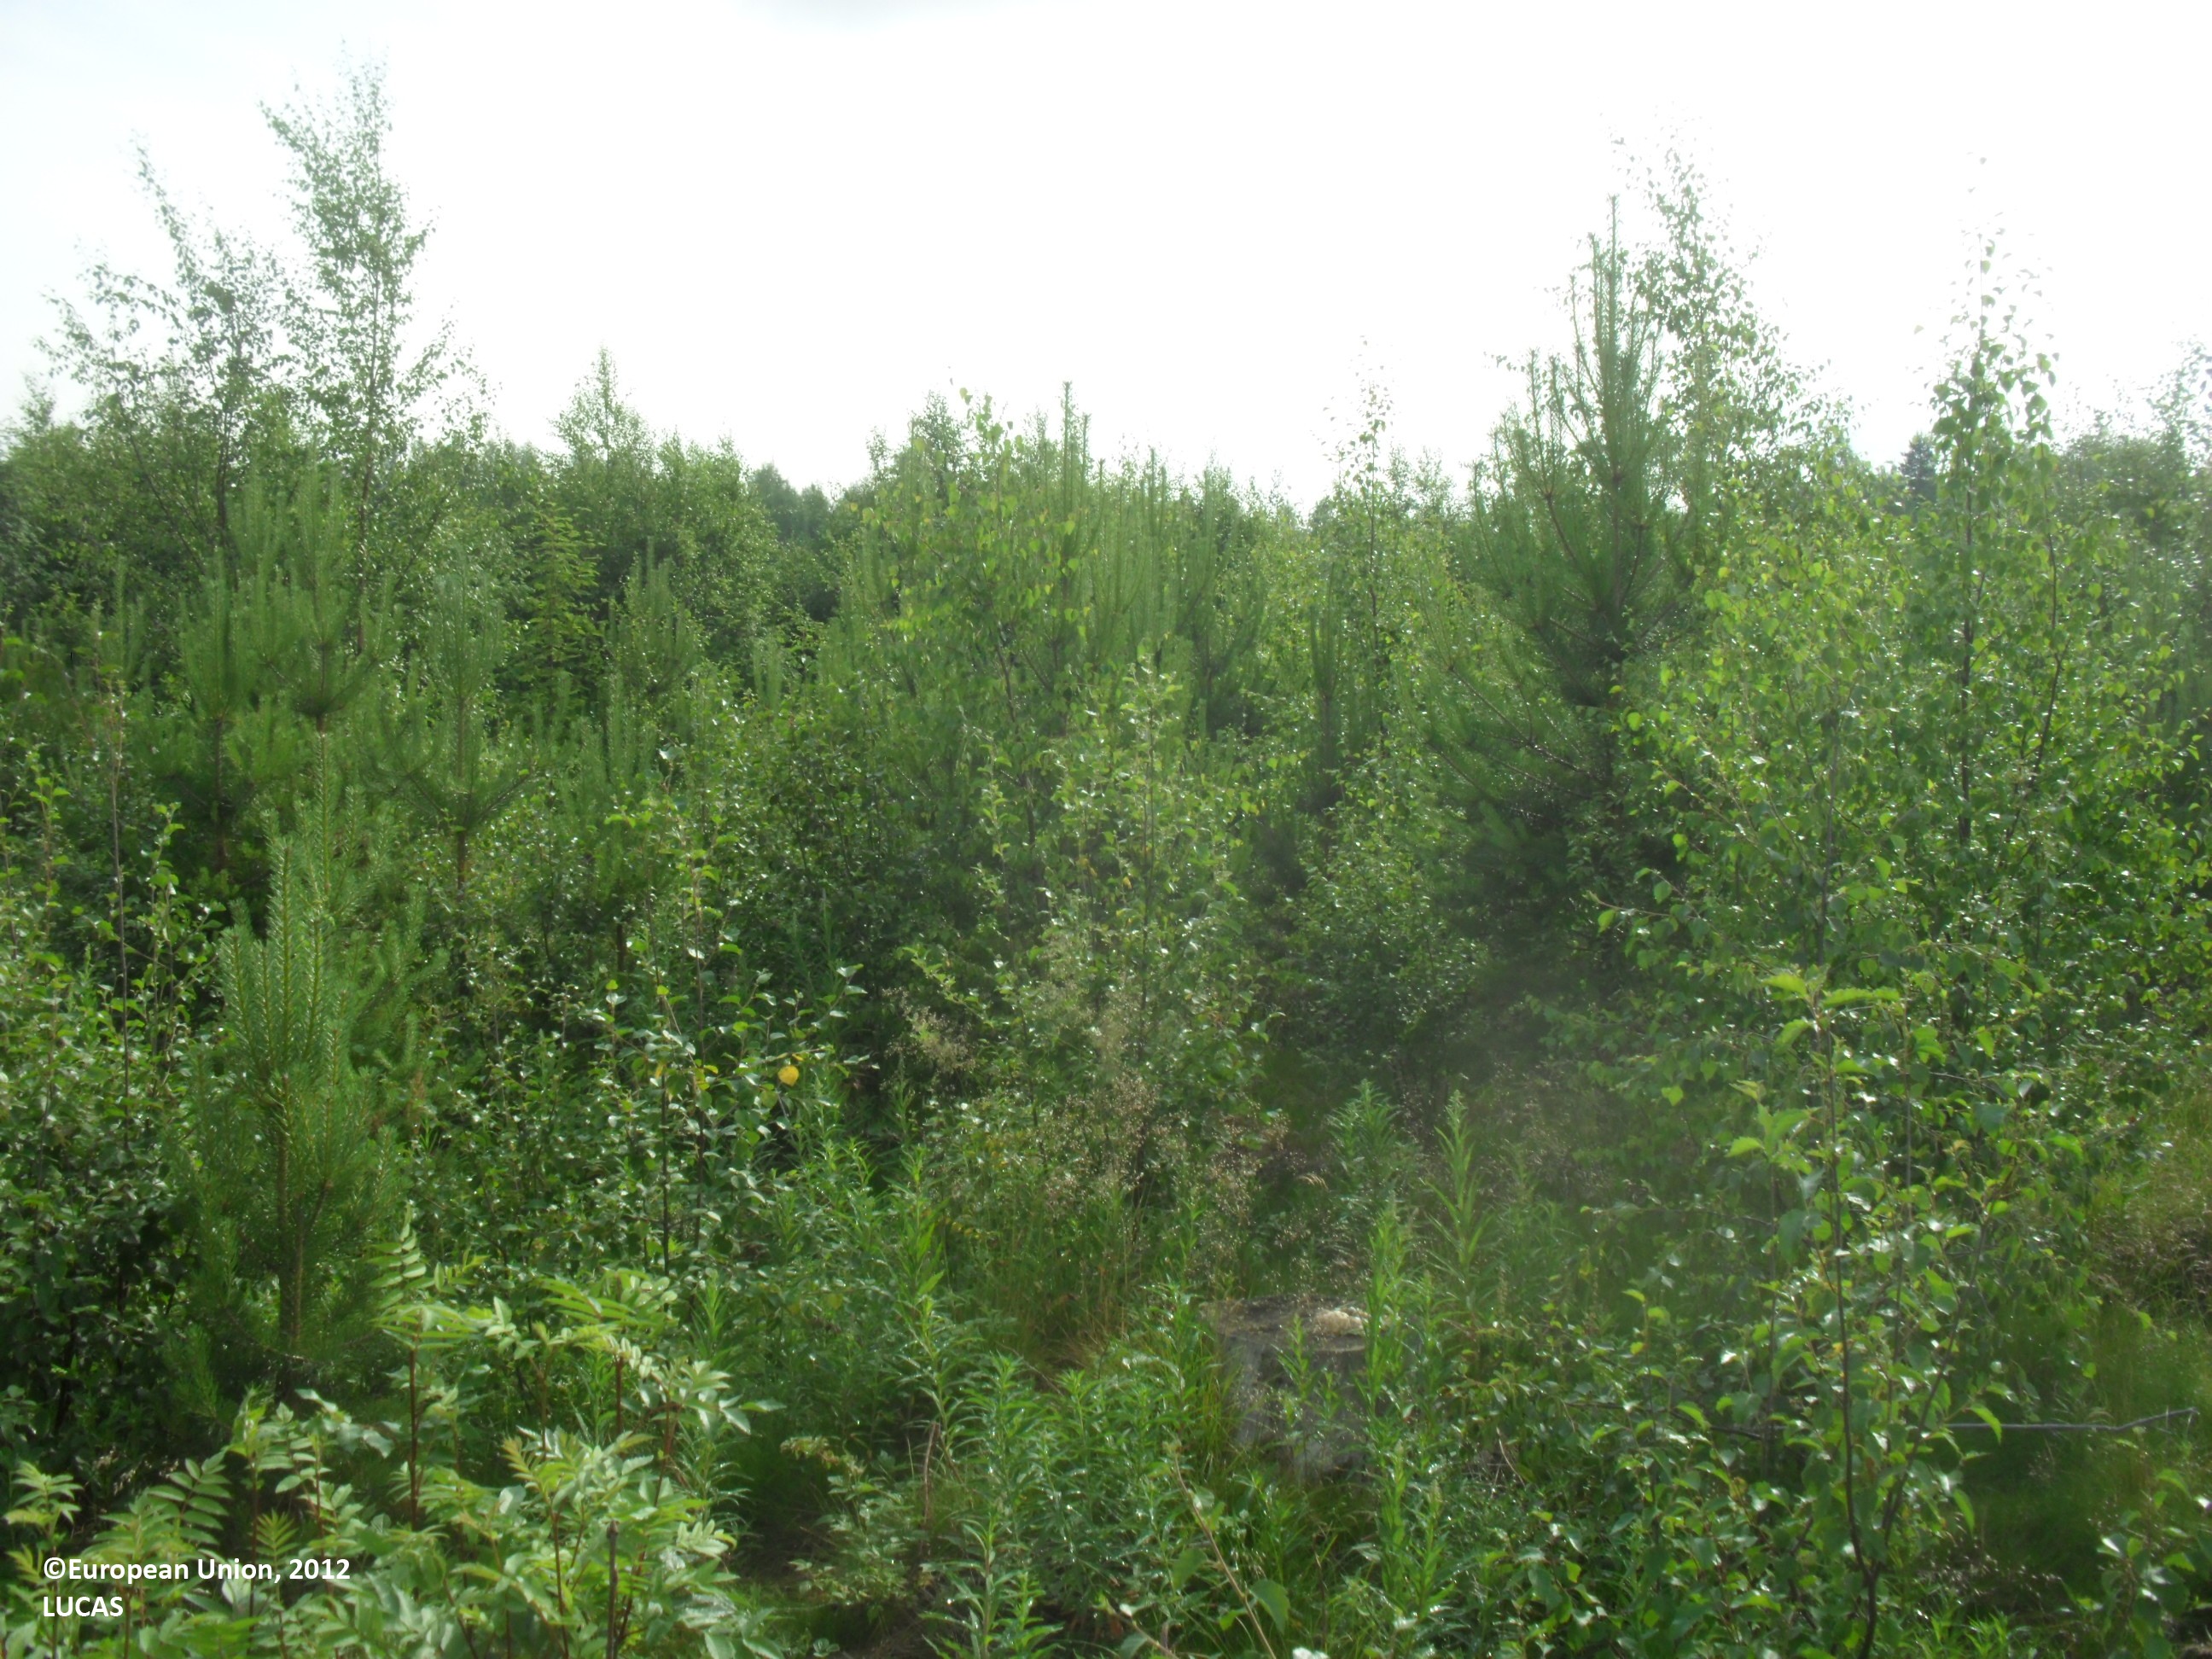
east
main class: Woodland
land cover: Other mixed woodland
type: boreal forest
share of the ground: 10 - 25 %
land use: Forestry
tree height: < 5 m
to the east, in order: Other mixed woodland; Spontaneously vegetated surfaces; Broadleaved woodland; Ditches and canals; Temporary grasslands; Broadleaved woodland; Inland running water; Other mixed woodland; Ditches and canals
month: July
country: FI
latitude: 63.4245
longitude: 23.5877
